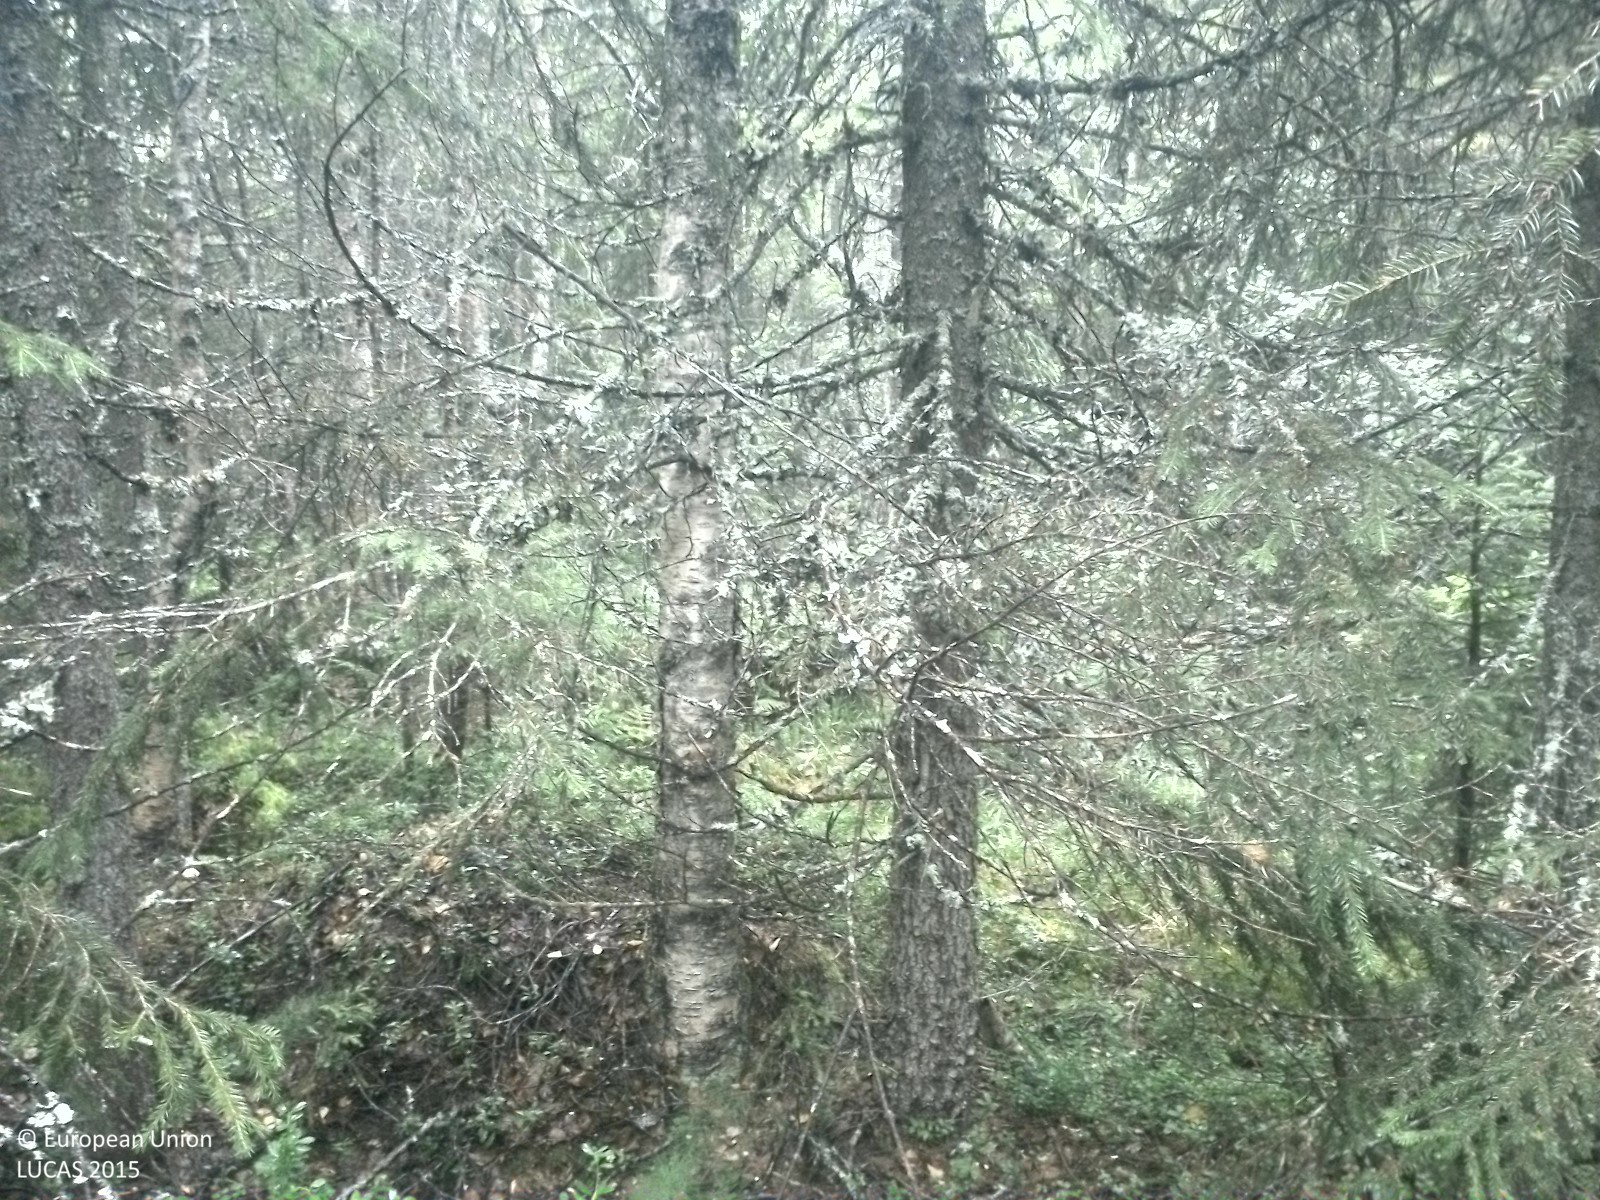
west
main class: Woodland
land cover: Spruce dominated mixed woodland
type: boreal forest
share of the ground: > 75 %
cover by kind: broadleaved forest trees 50 %, coniferous forest trees 35 %, shrubs 15 %
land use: Semi-natural and natural areas not in use
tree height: > 5 m
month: August
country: SE
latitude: 62.3002
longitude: 16.2859
